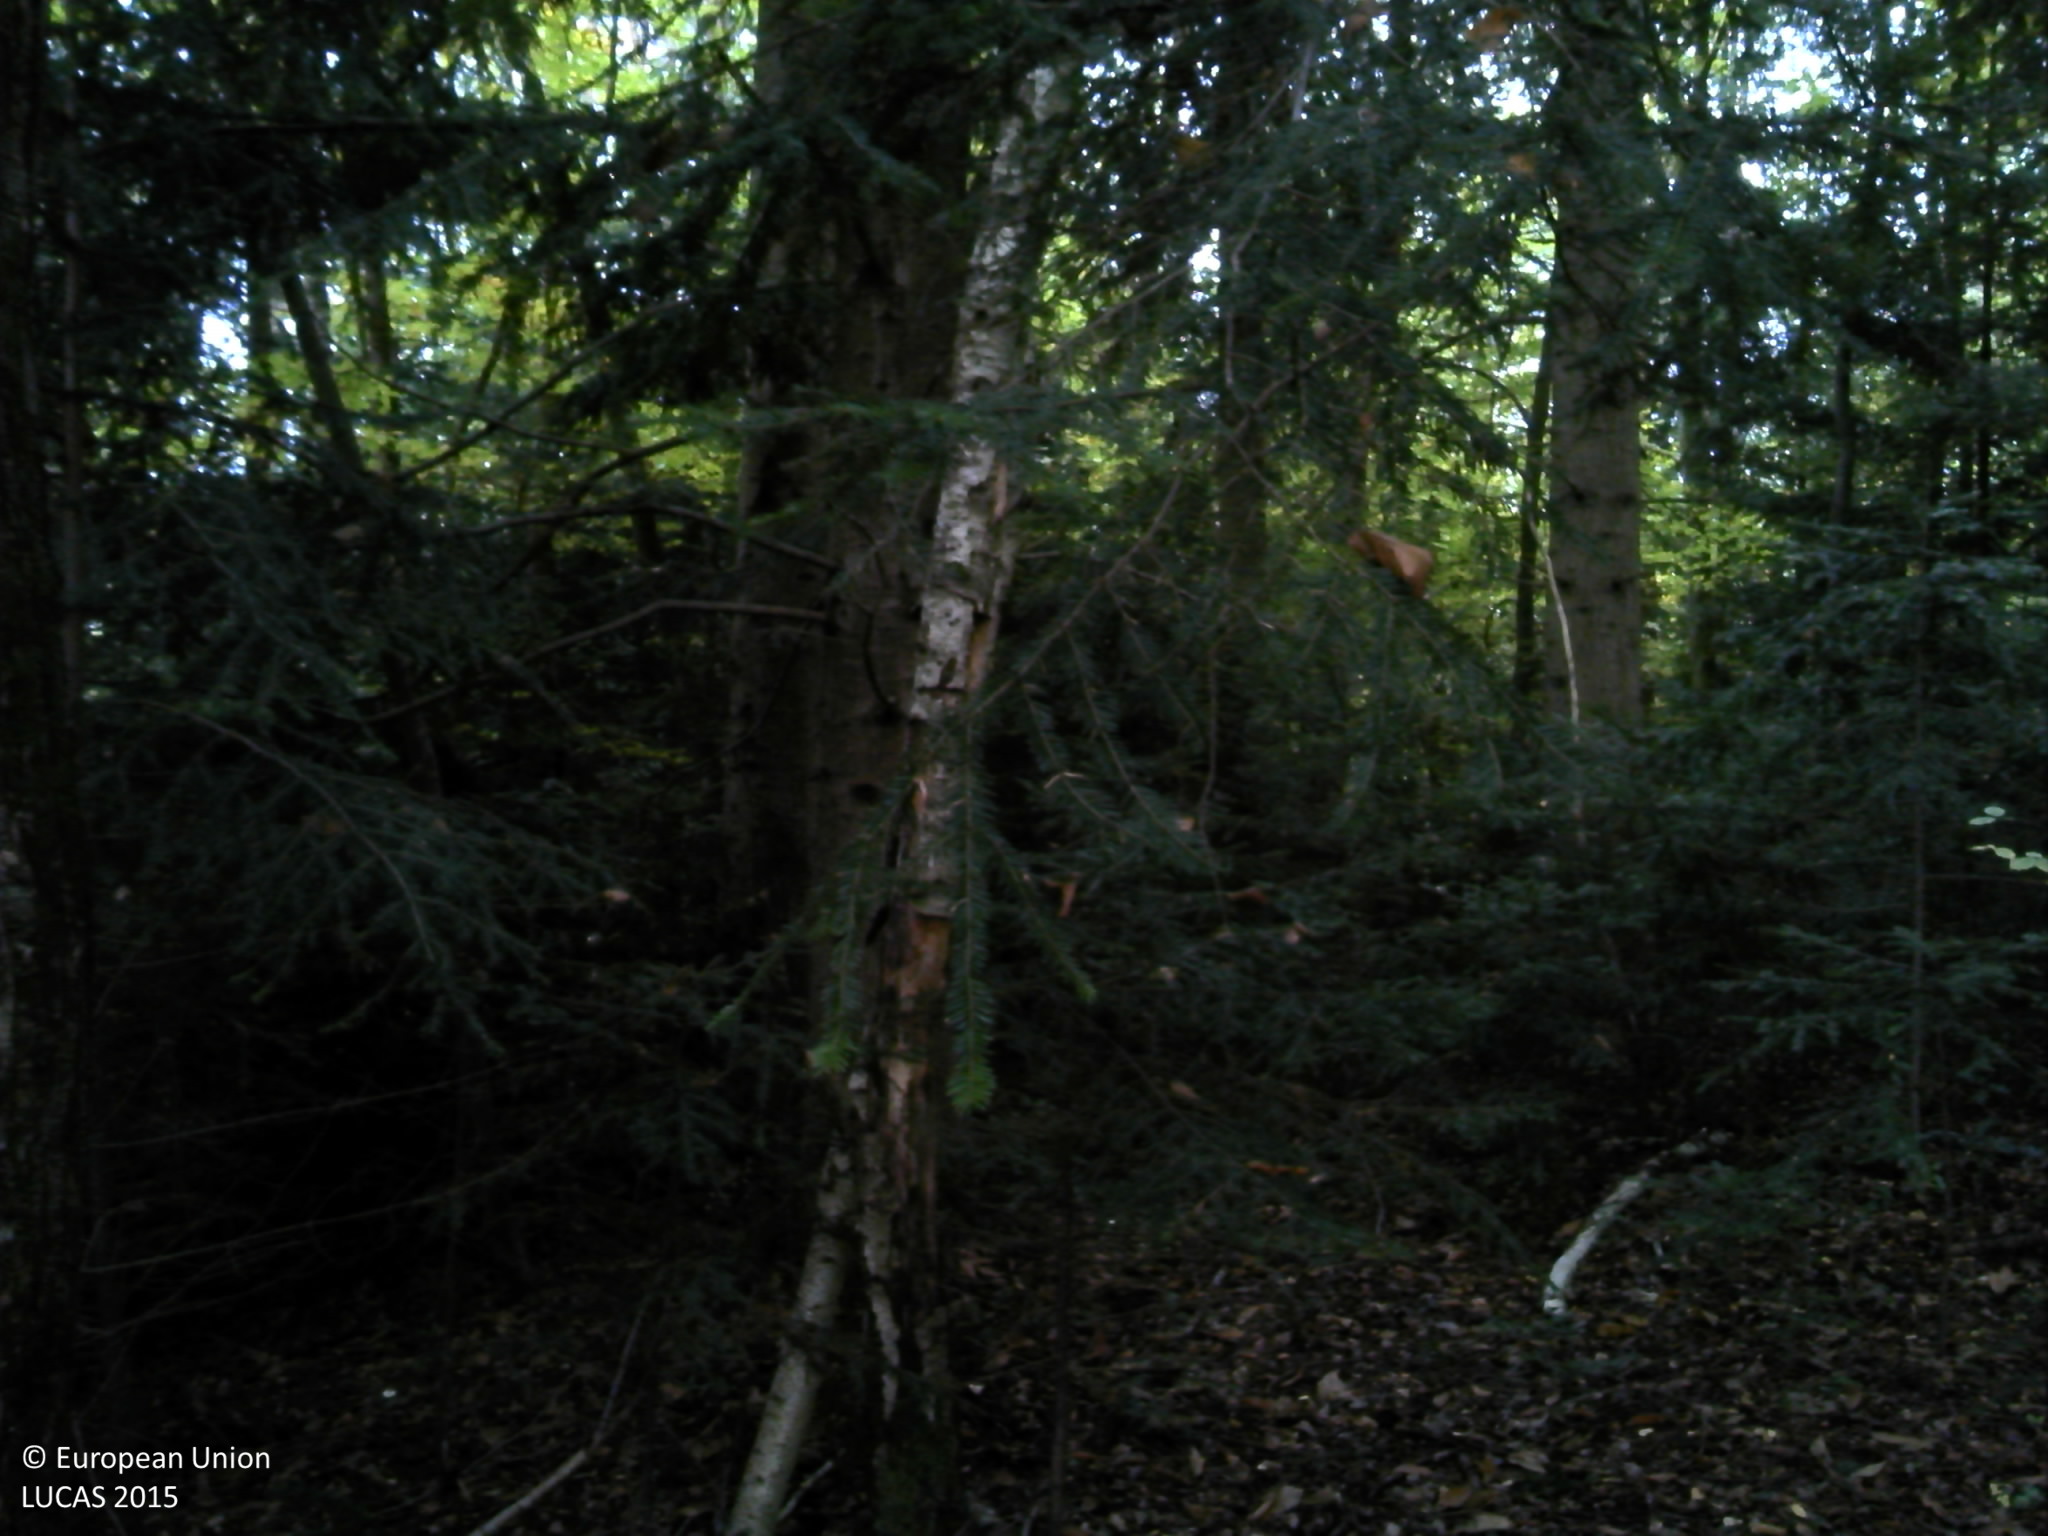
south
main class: Woodland
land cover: Spruce dominated mixed woodland
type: acidophilous oak and oak-birch forest
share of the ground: > 75 %
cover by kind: coniferous forest trees 60 %, broadleaved forest trees 30 %, unconsolidated bare surface 10 %
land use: Forestry
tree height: > 5 m
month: October
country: FR
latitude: 45.6596
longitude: 3.7004
